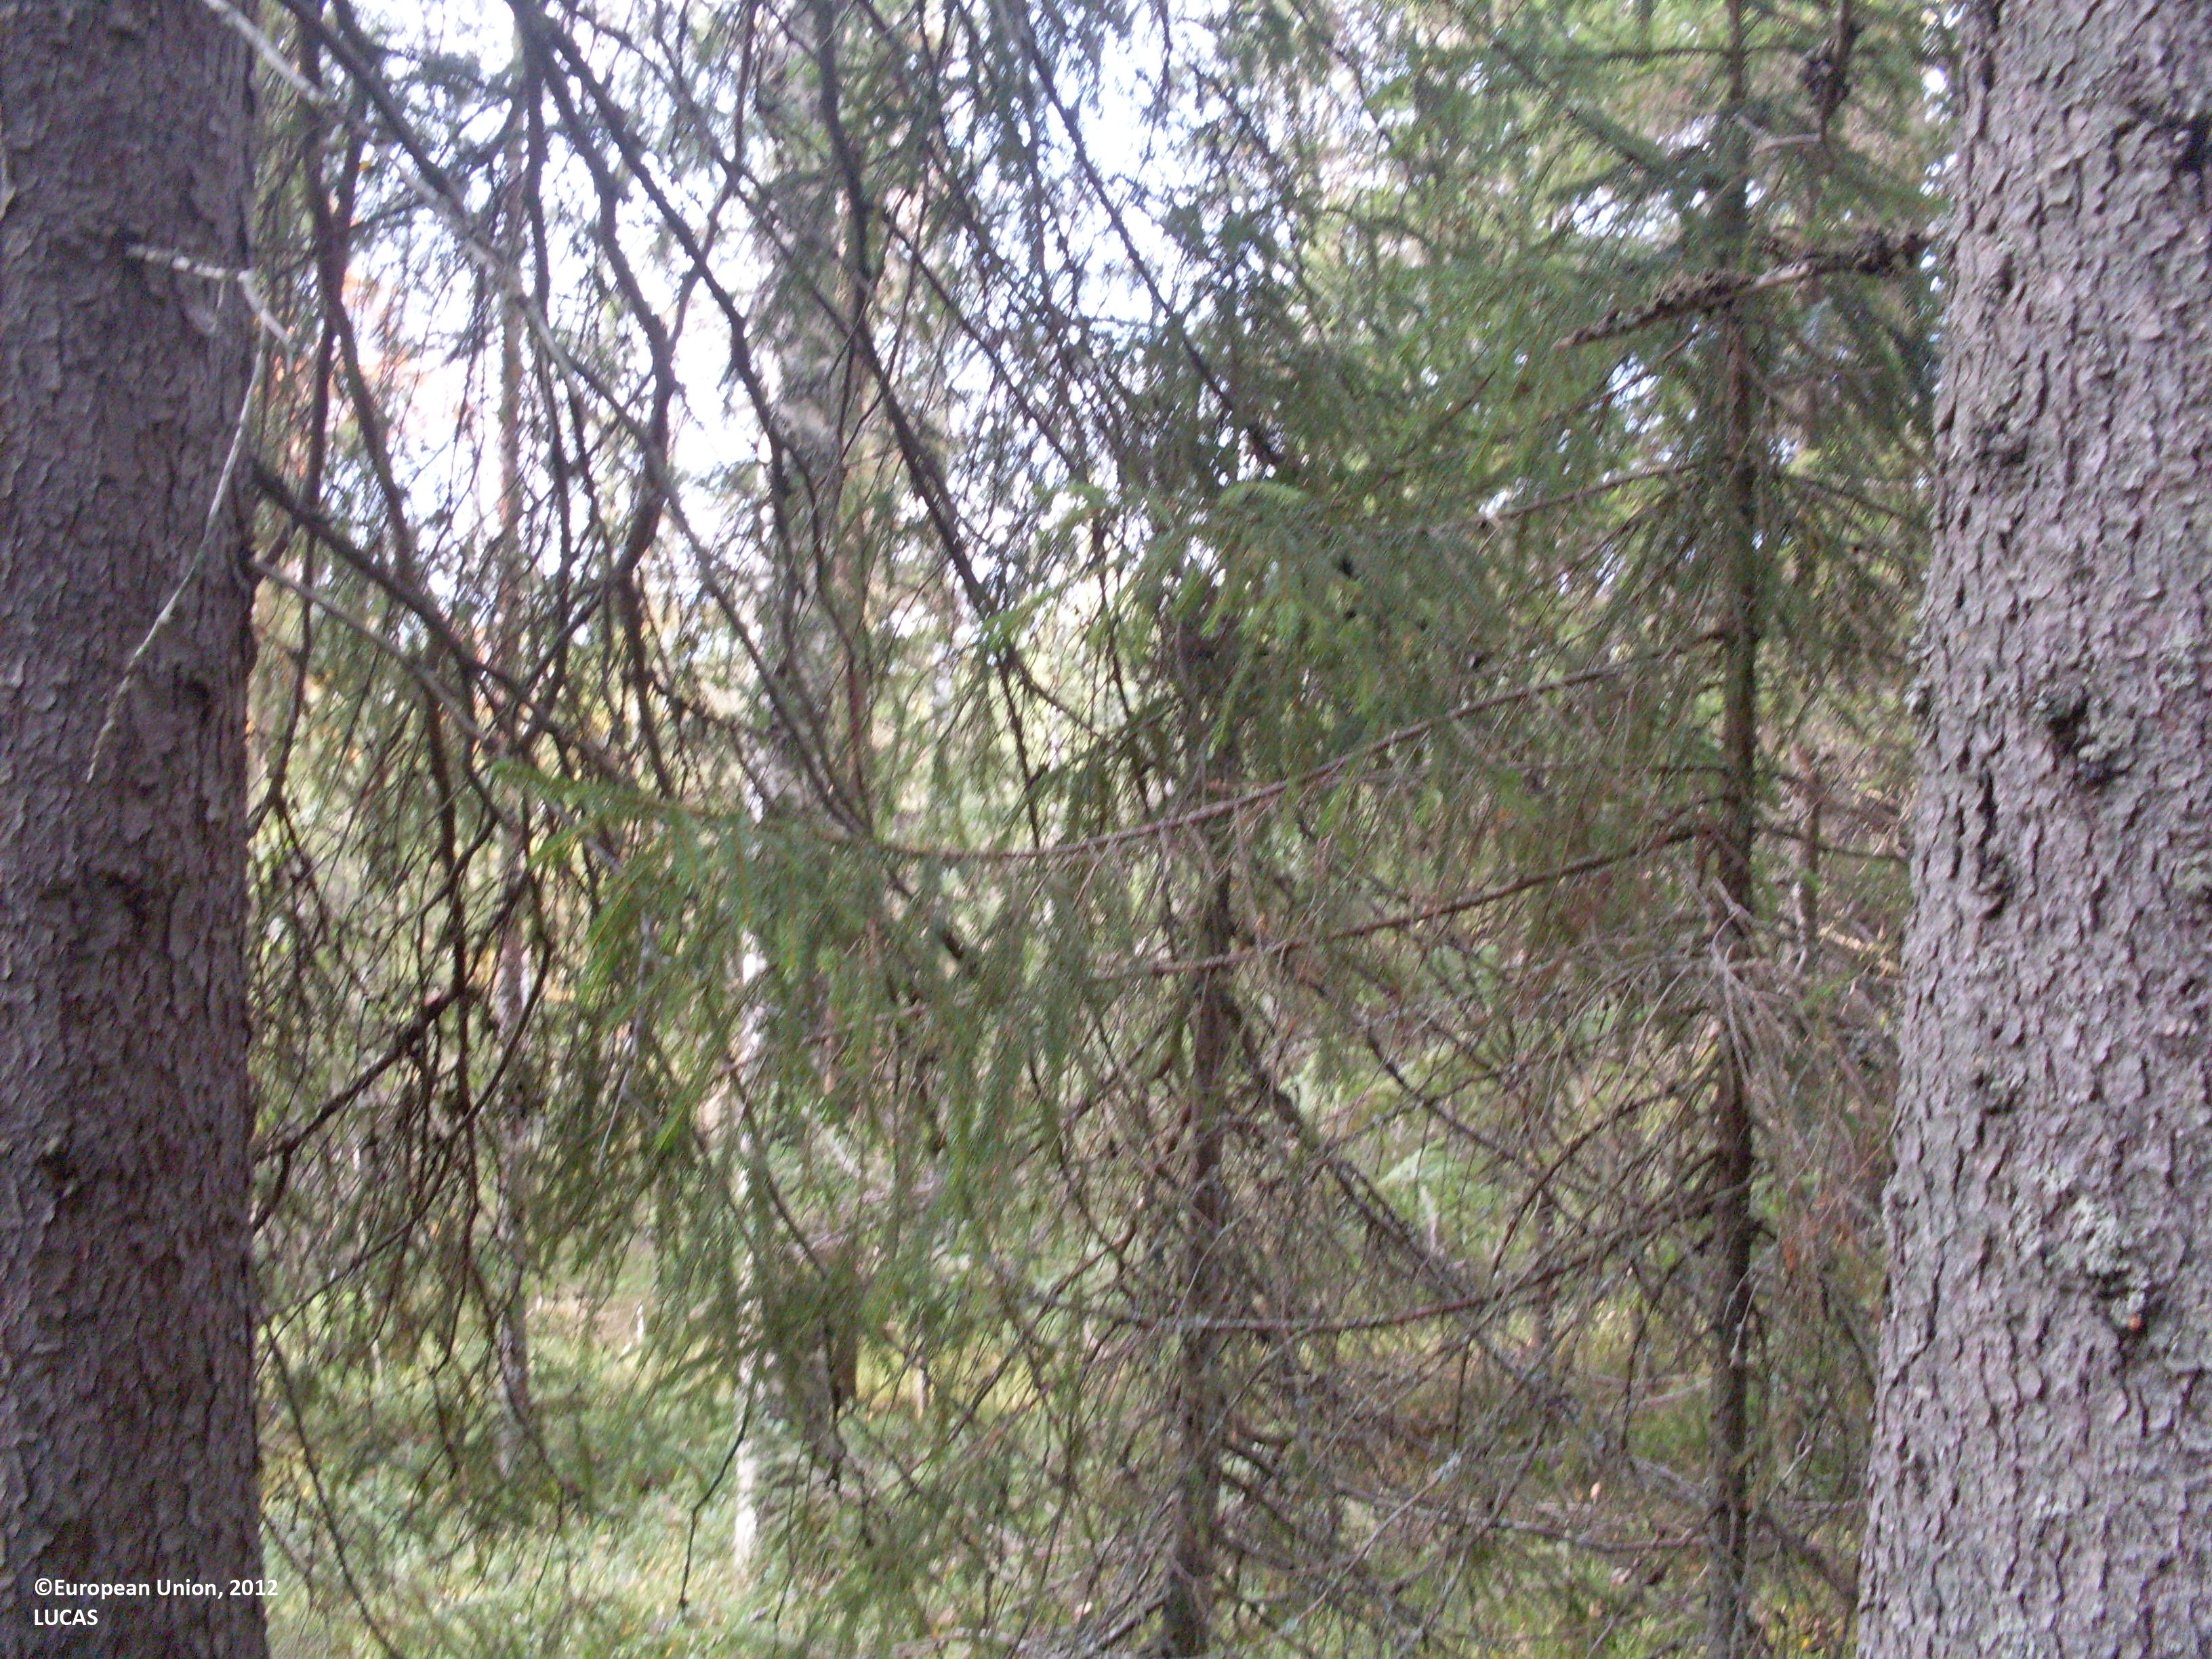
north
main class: Woodland
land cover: Spruce dominated mixed woodland
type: boreal forest
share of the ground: > 75 %
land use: Forestry
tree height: > 5 m
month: September
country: FI
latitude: 64.3924
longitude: 28.5309
